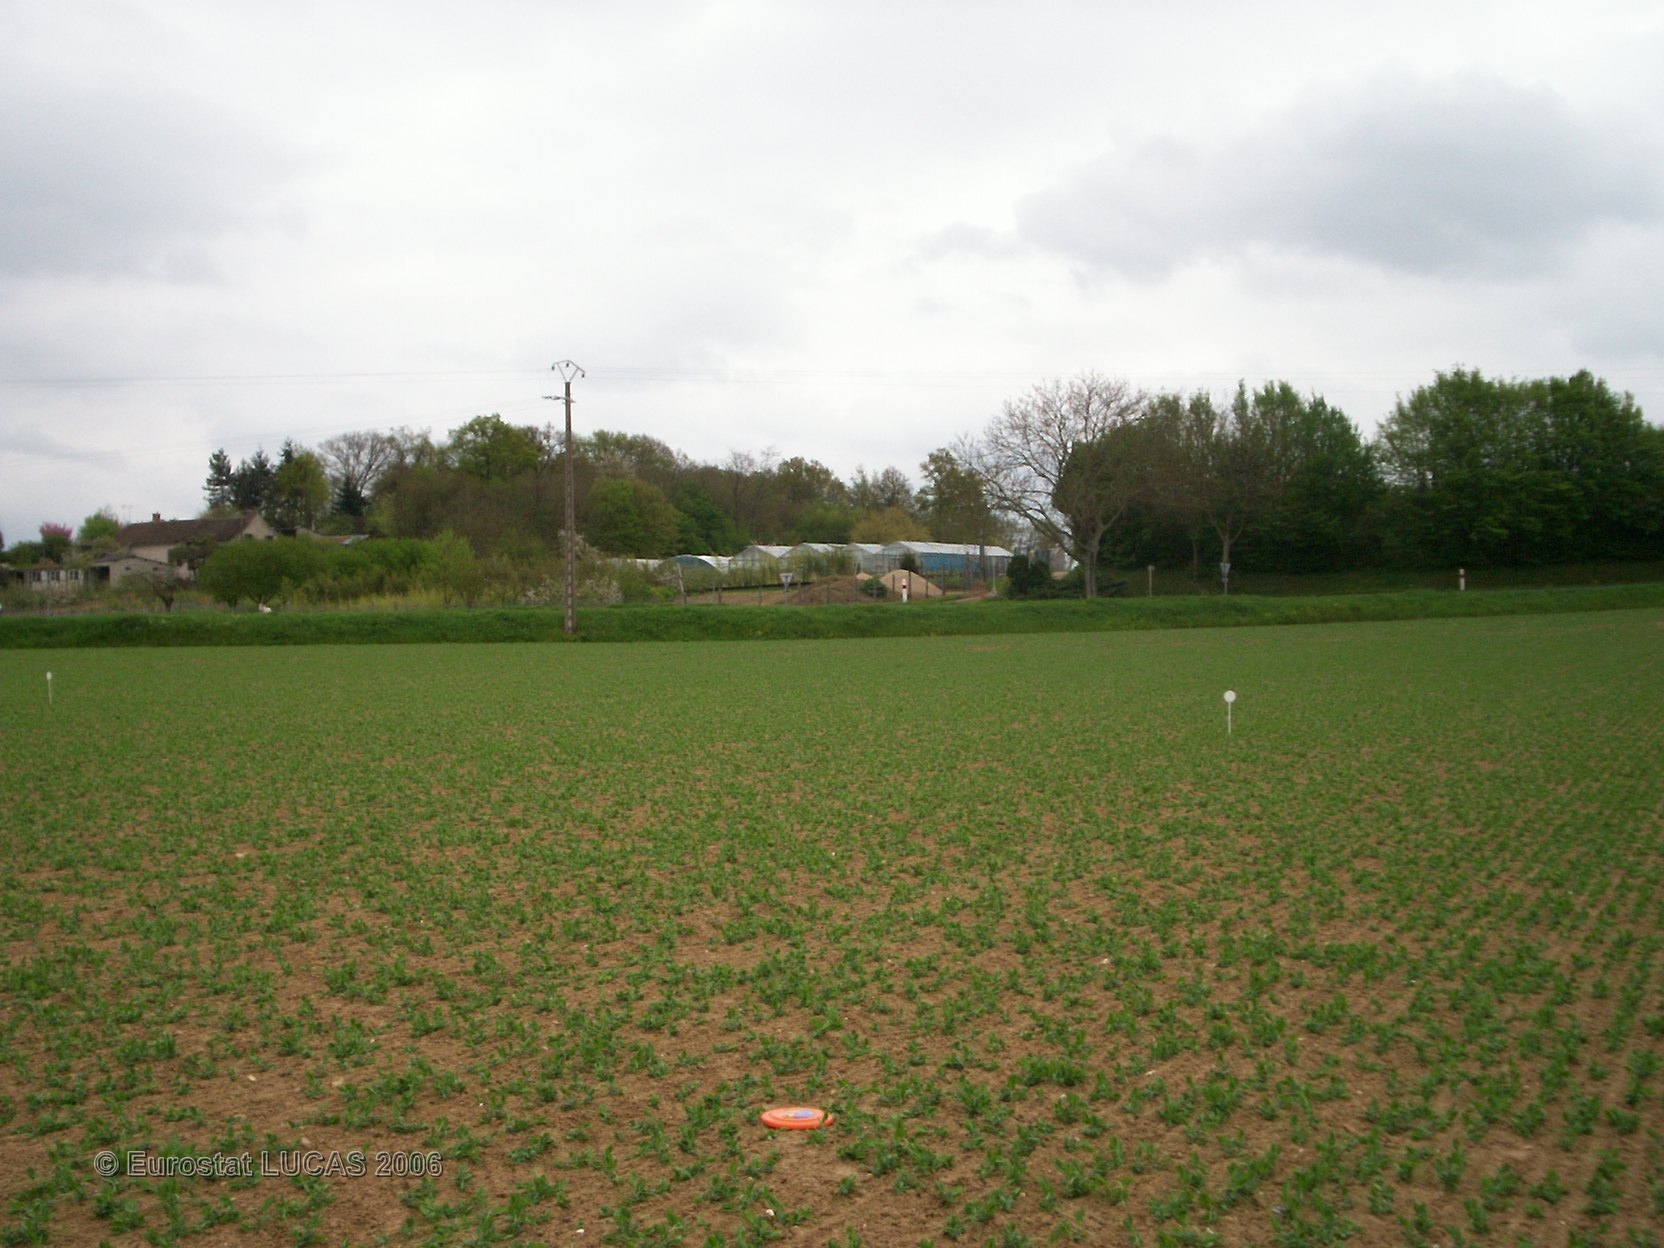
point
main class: Cropland
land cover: Dry pulses
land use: Agriculture (excluding fallow land and kitchen gardens)
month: May
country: FR
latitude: 48.1397
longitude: 2.9099
